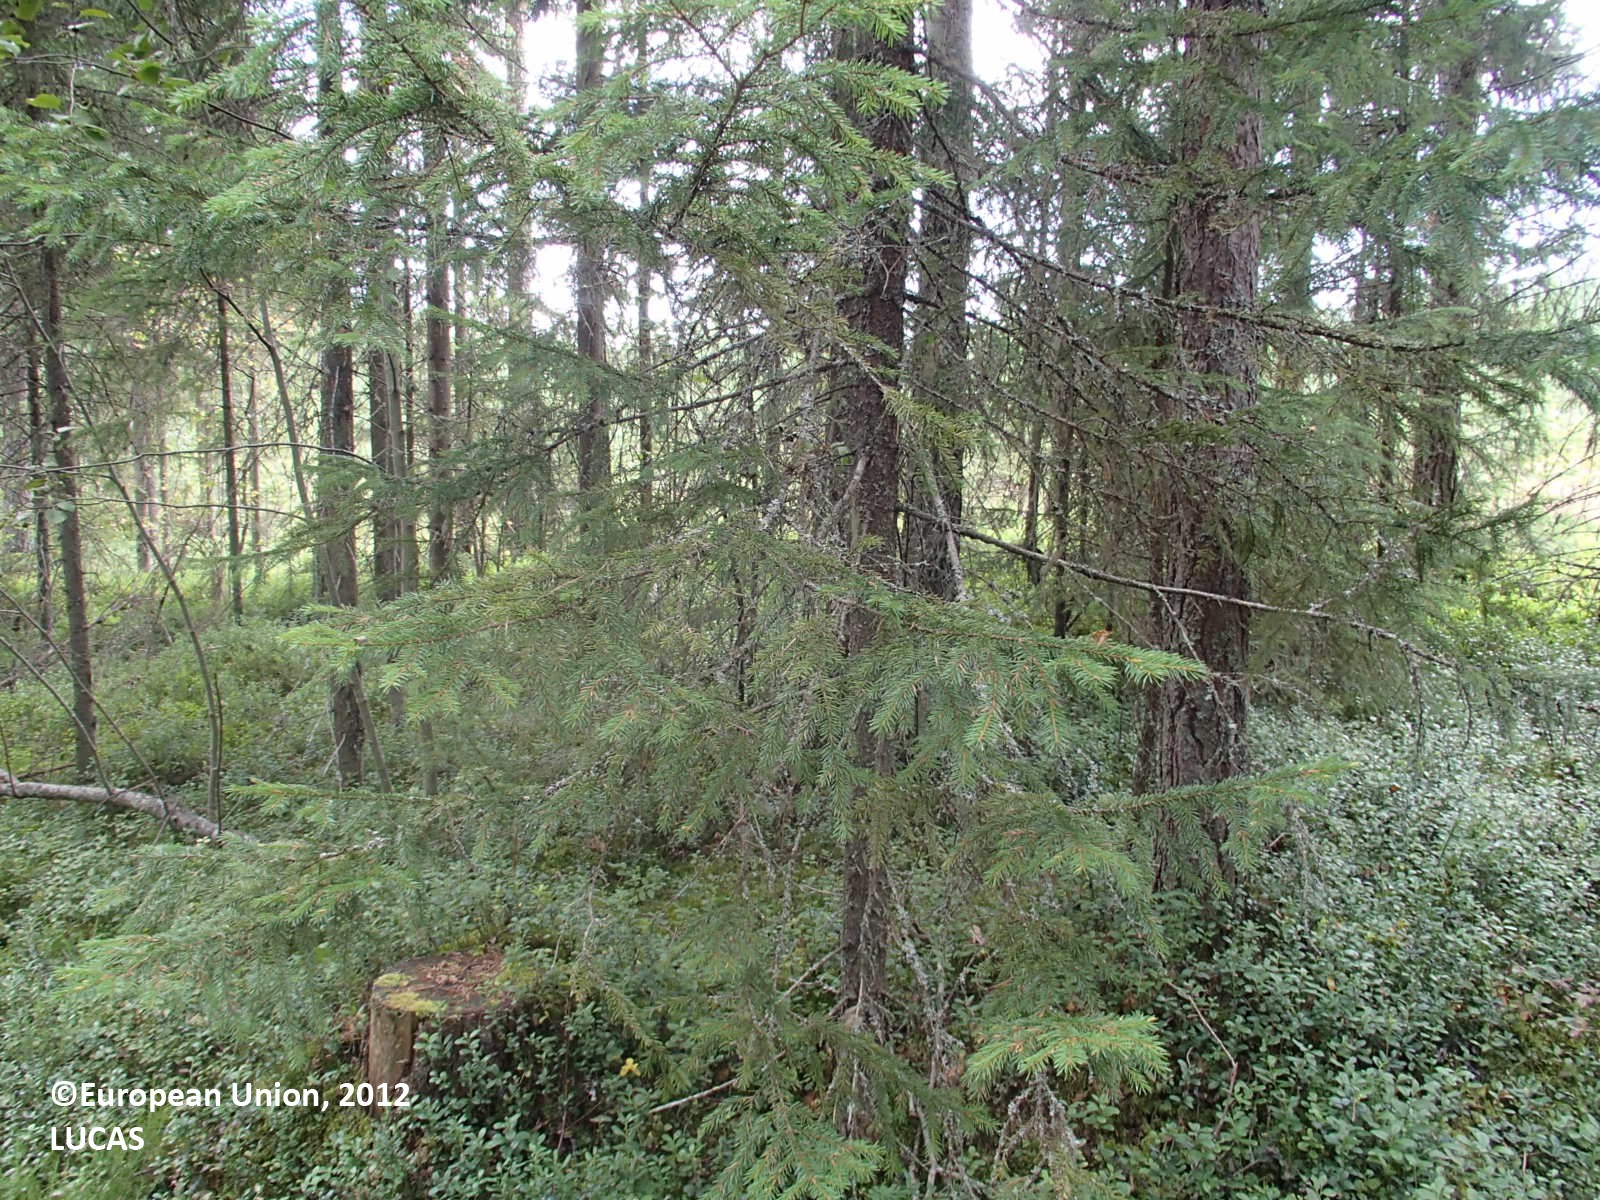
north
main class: Woodland
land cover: Other mixed woodland
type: boreal forest
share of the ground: > 75 %
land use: Forestry
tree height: > 5 m
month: August
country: FI
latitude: 63.9668
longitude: 25.6403
